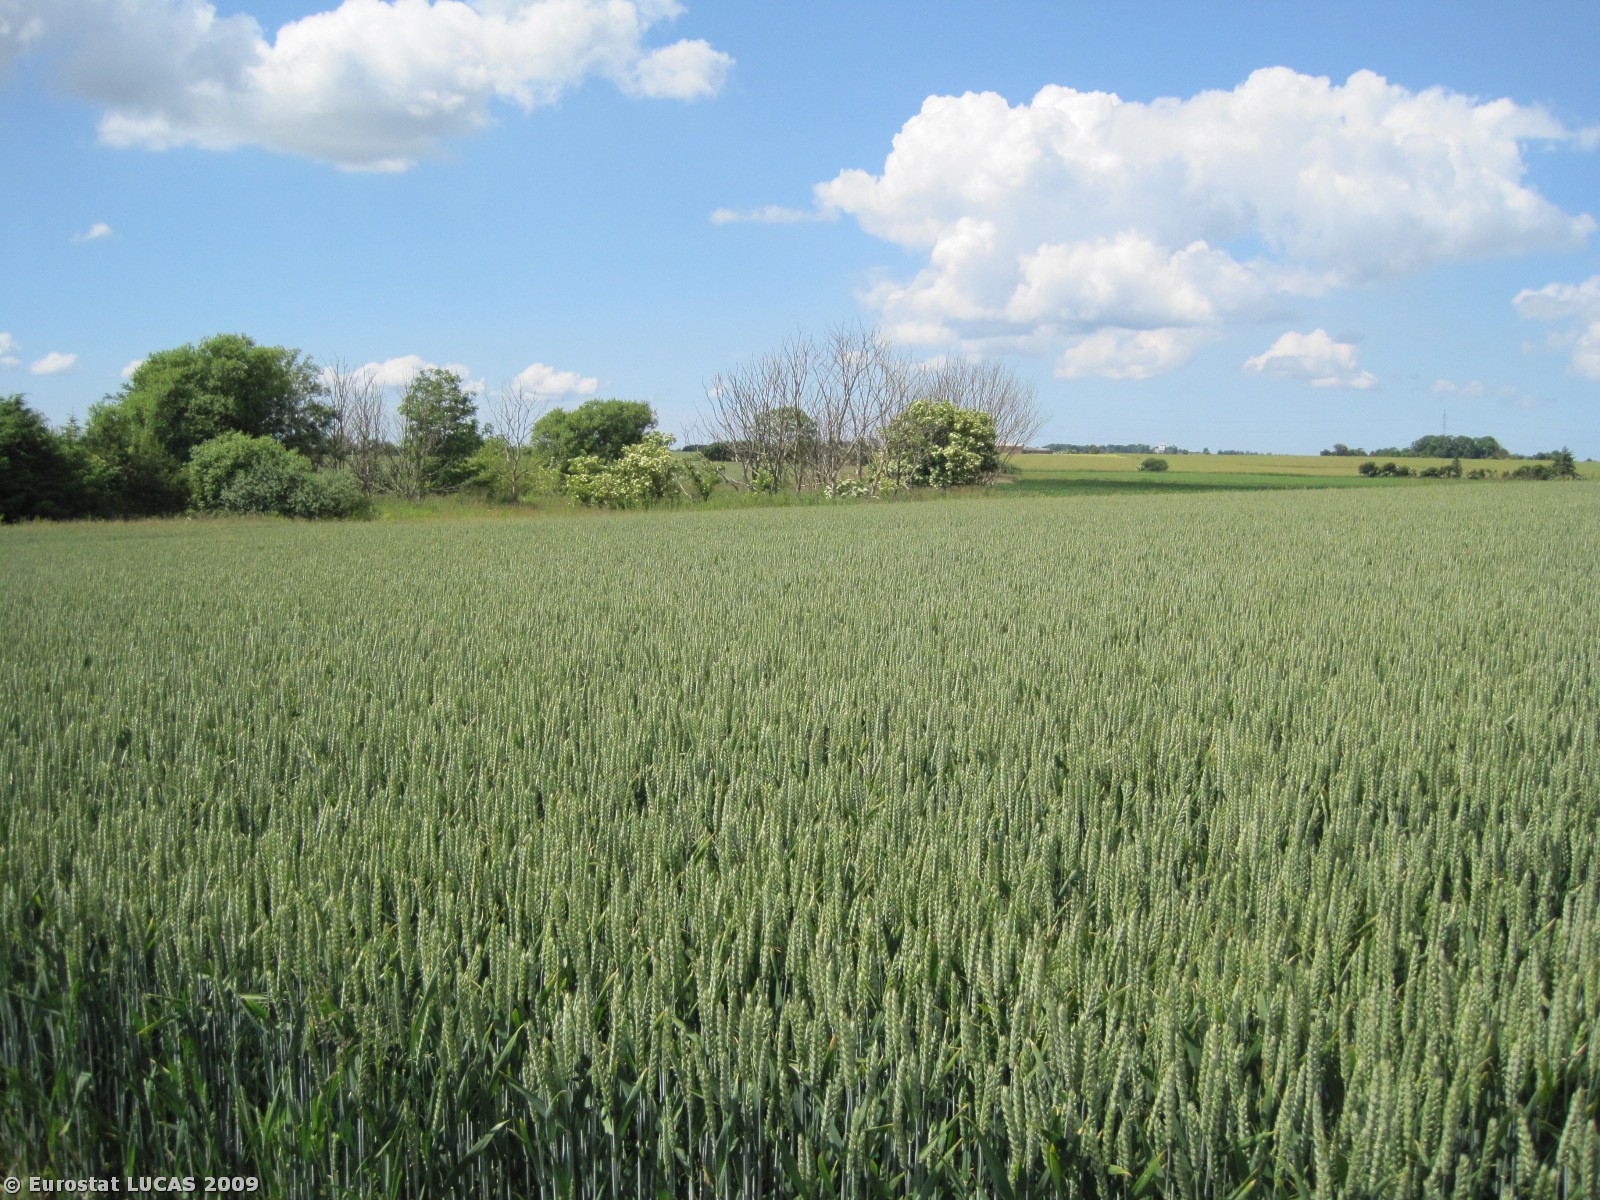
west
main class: Cropland
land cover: Common wheat
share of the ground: > 75 %
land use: Agriculture (excluding fallow land and kitchen gardens)
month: June
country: DK
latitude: 56.6870
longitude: 8.9729
